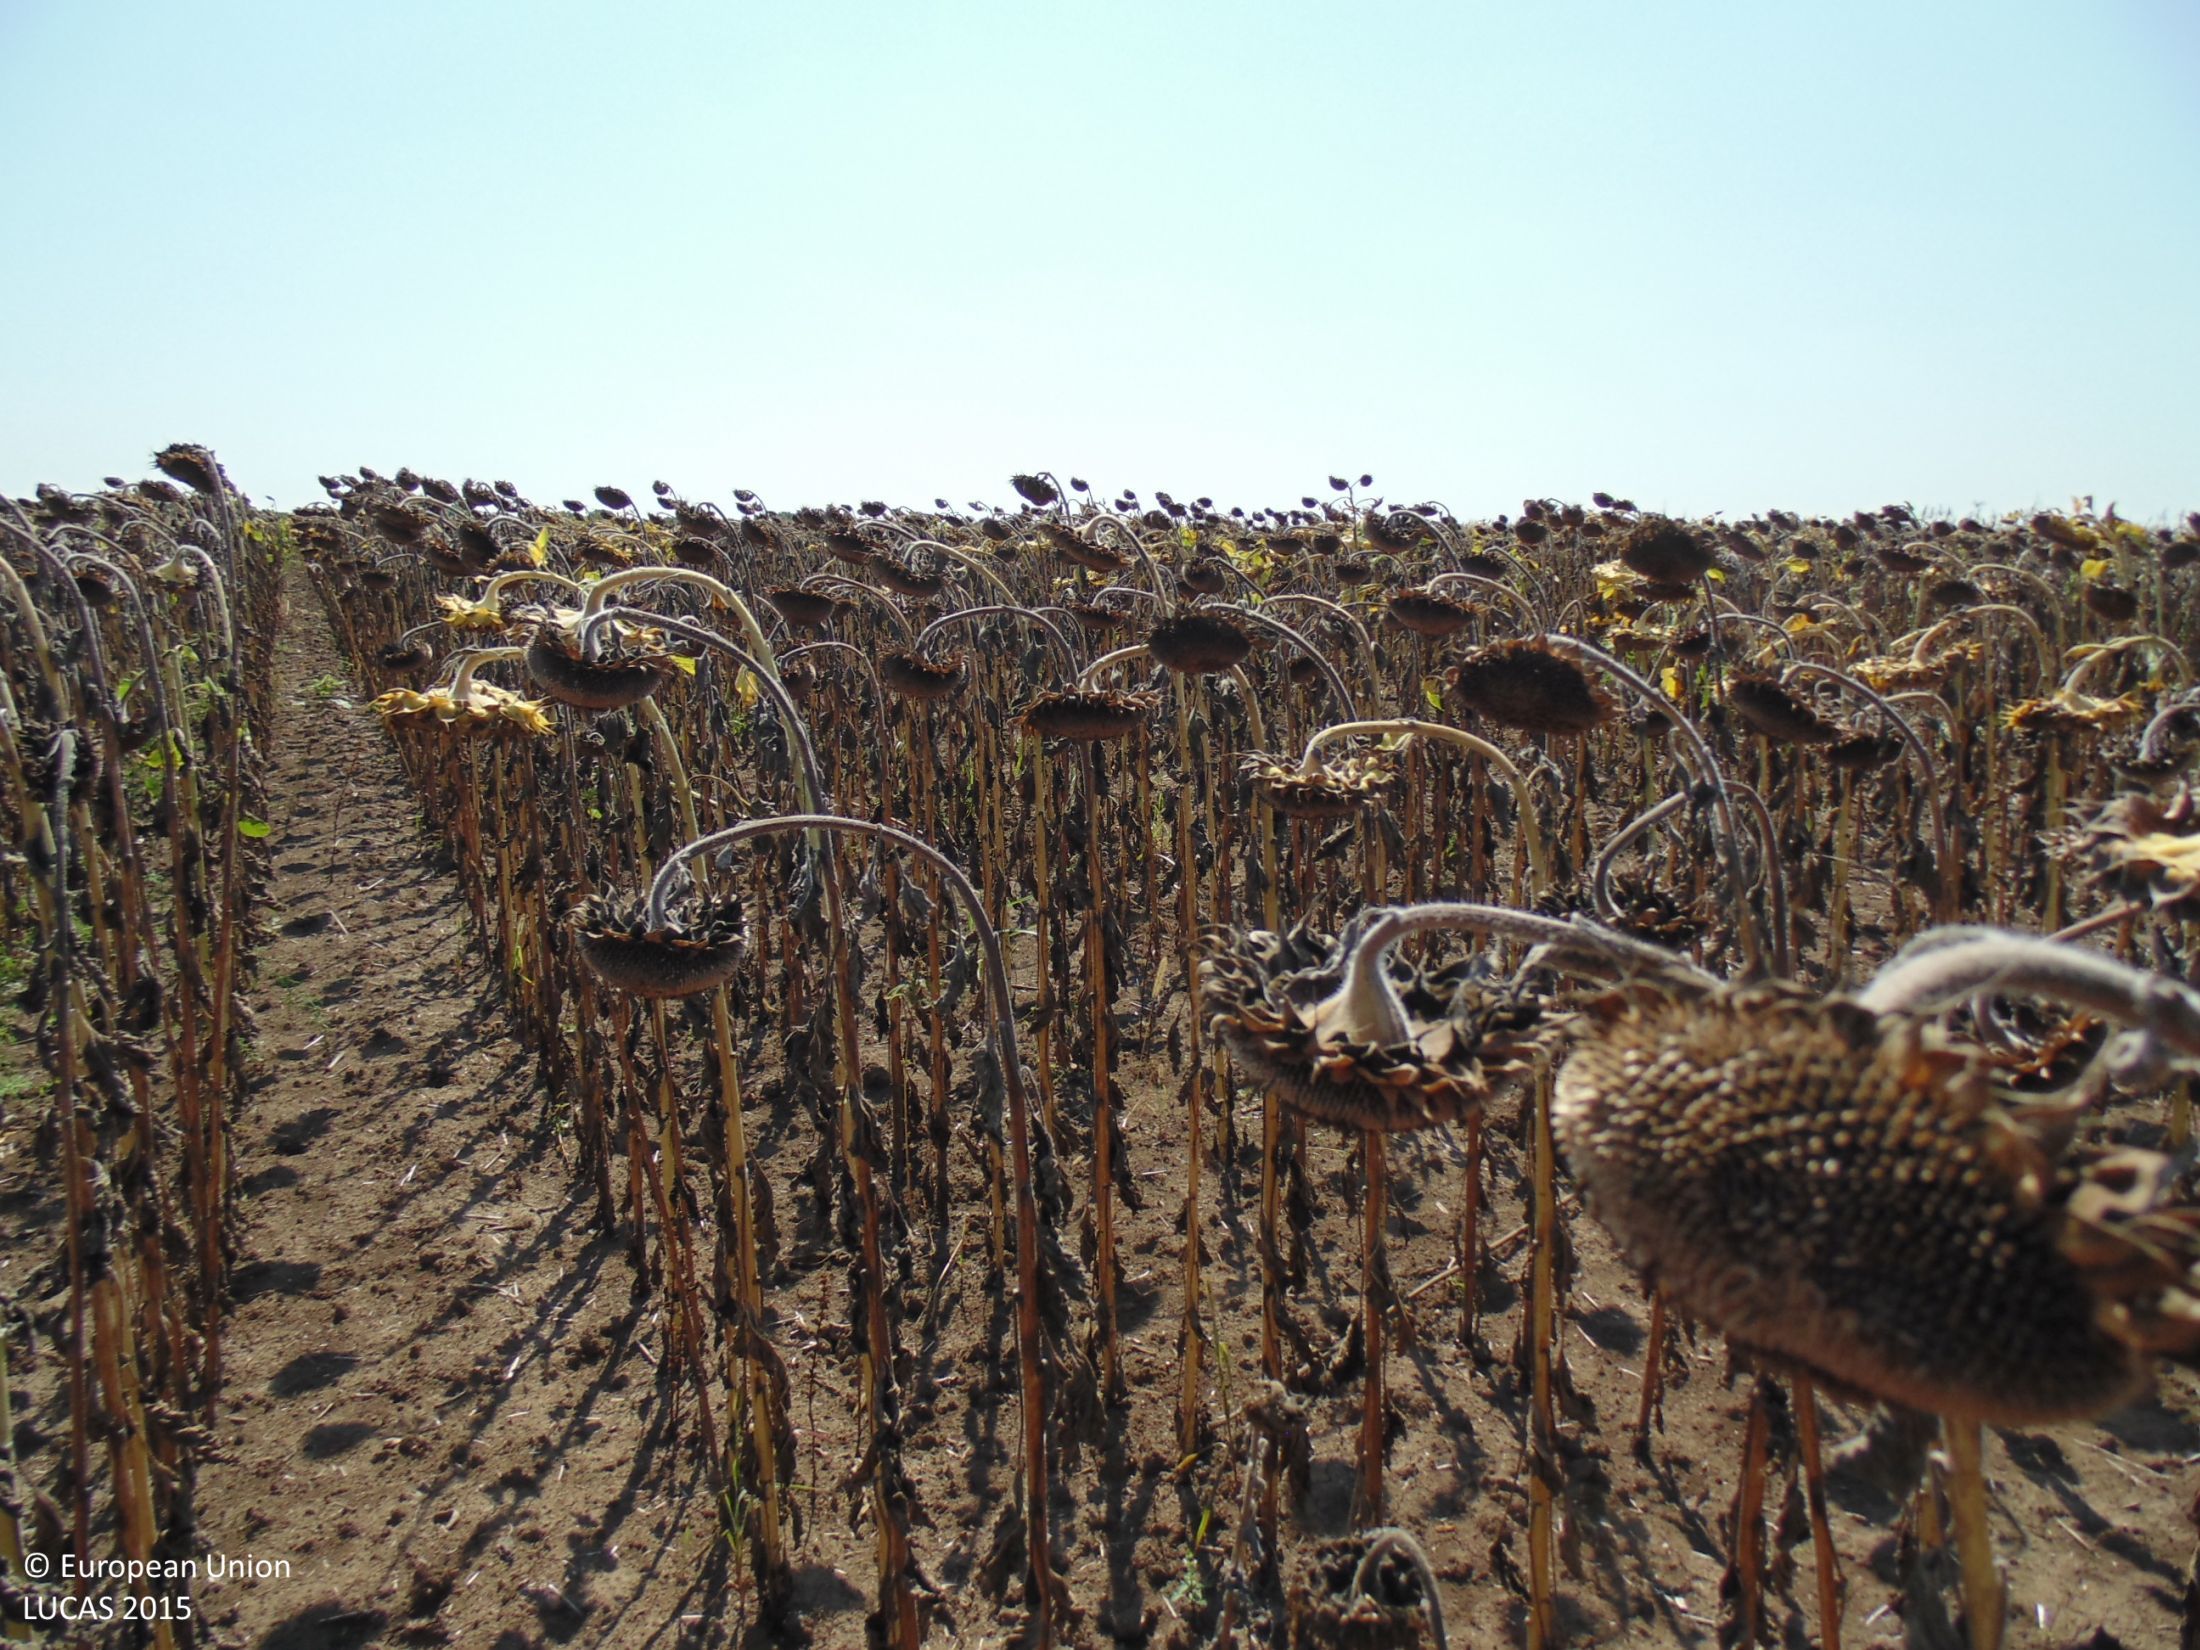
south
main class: Cropland
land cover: Sunflower
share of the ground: > 75 %
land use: Agriculture (excluding fallow land and kitchen gardens)
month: August
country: BG
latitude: 43.7239
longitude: 27.4491
